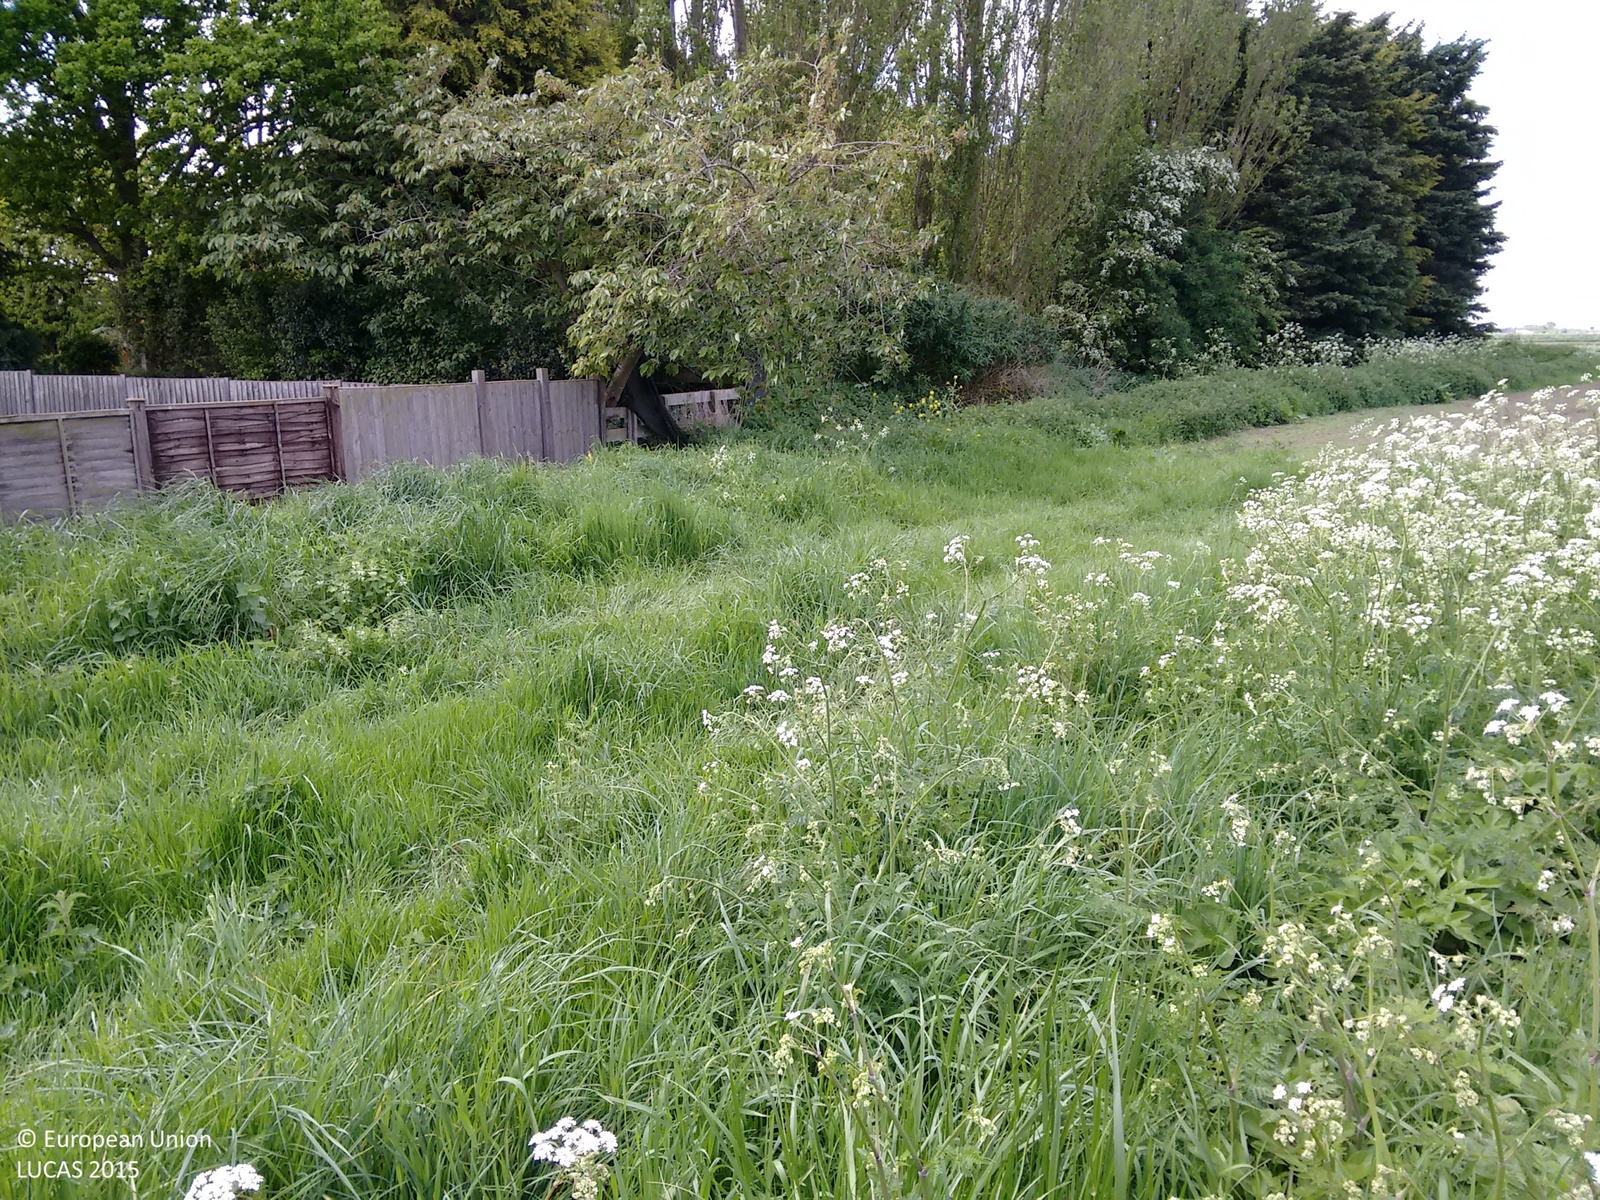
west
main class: Grassland
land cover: Grassland without tree/shrub cover
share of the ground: > 75 %
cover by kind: herbaceous plants 100 %
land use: Agriculture (excluding fallow land and kitchen gardens)
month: May
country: GB
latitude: 52.9442
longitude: -0.0780
